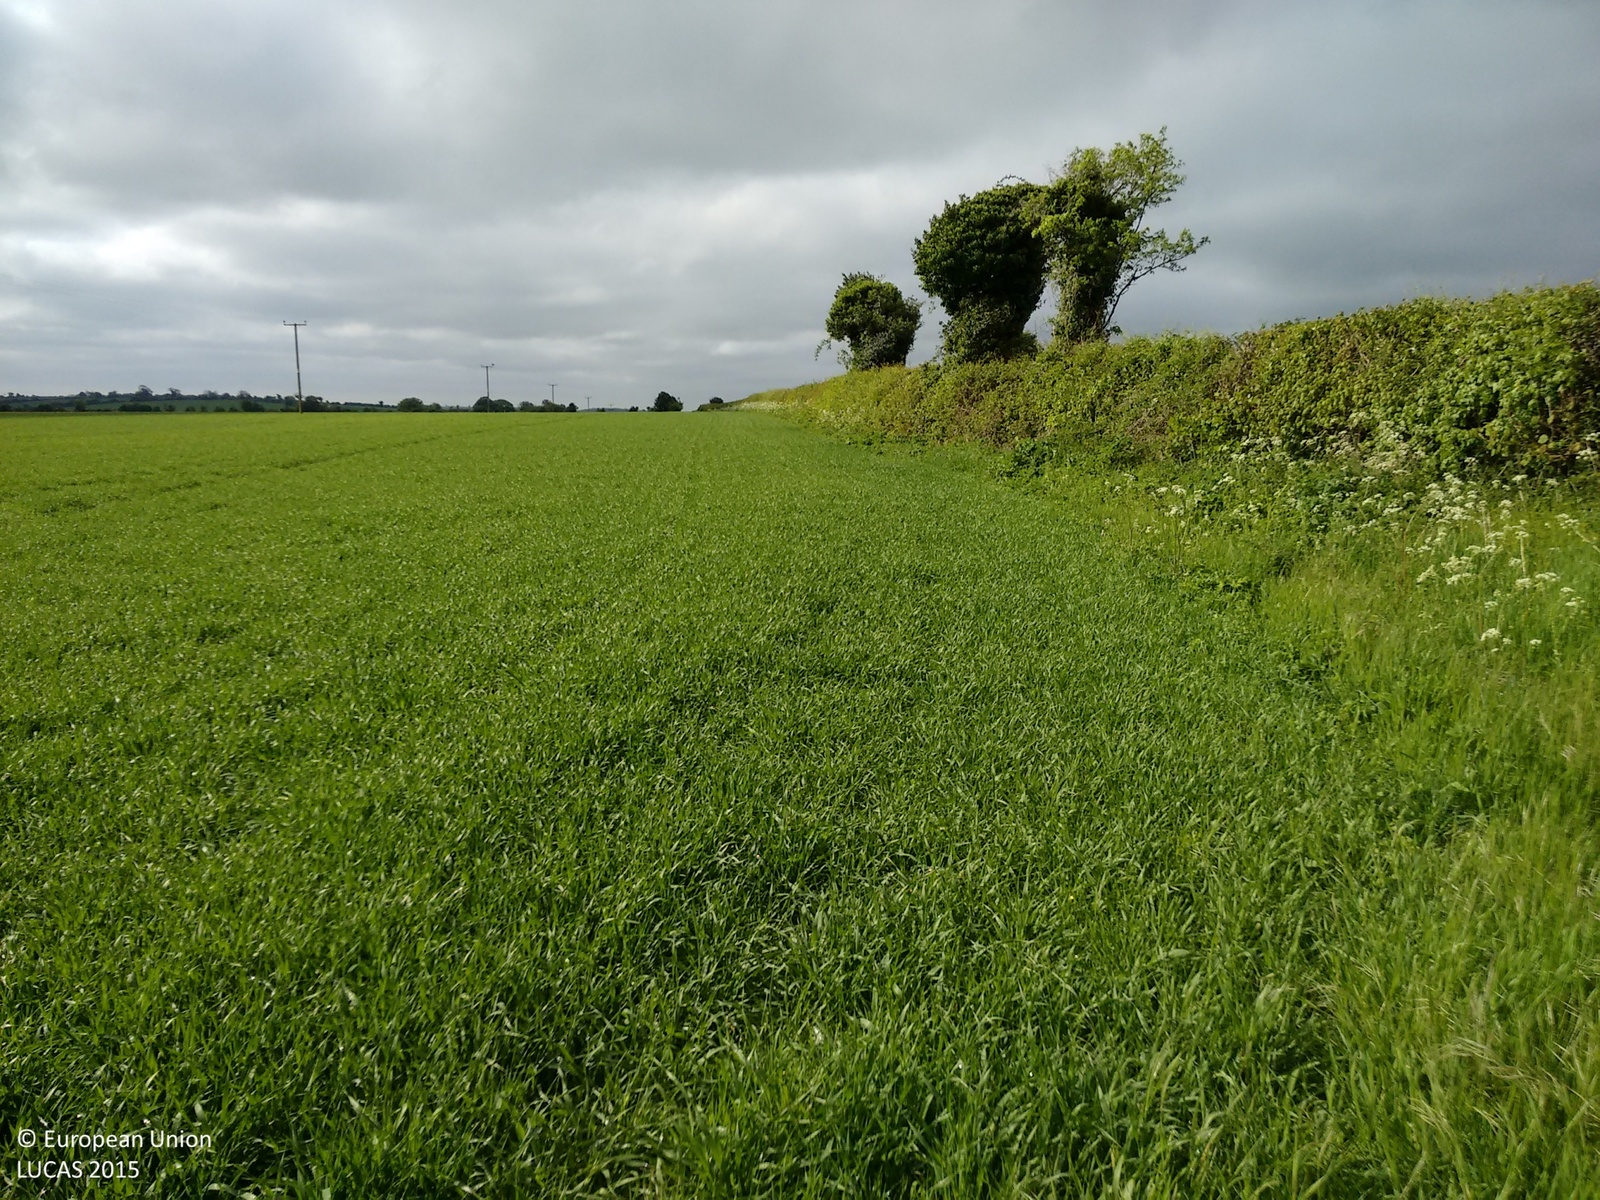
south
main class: Cropland
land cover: Barley
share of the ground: > 75 %
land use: Agriculture (excluding fallow land and kitchen gardens)
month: May
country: GB
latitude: 50.9242
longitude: -2.0520
